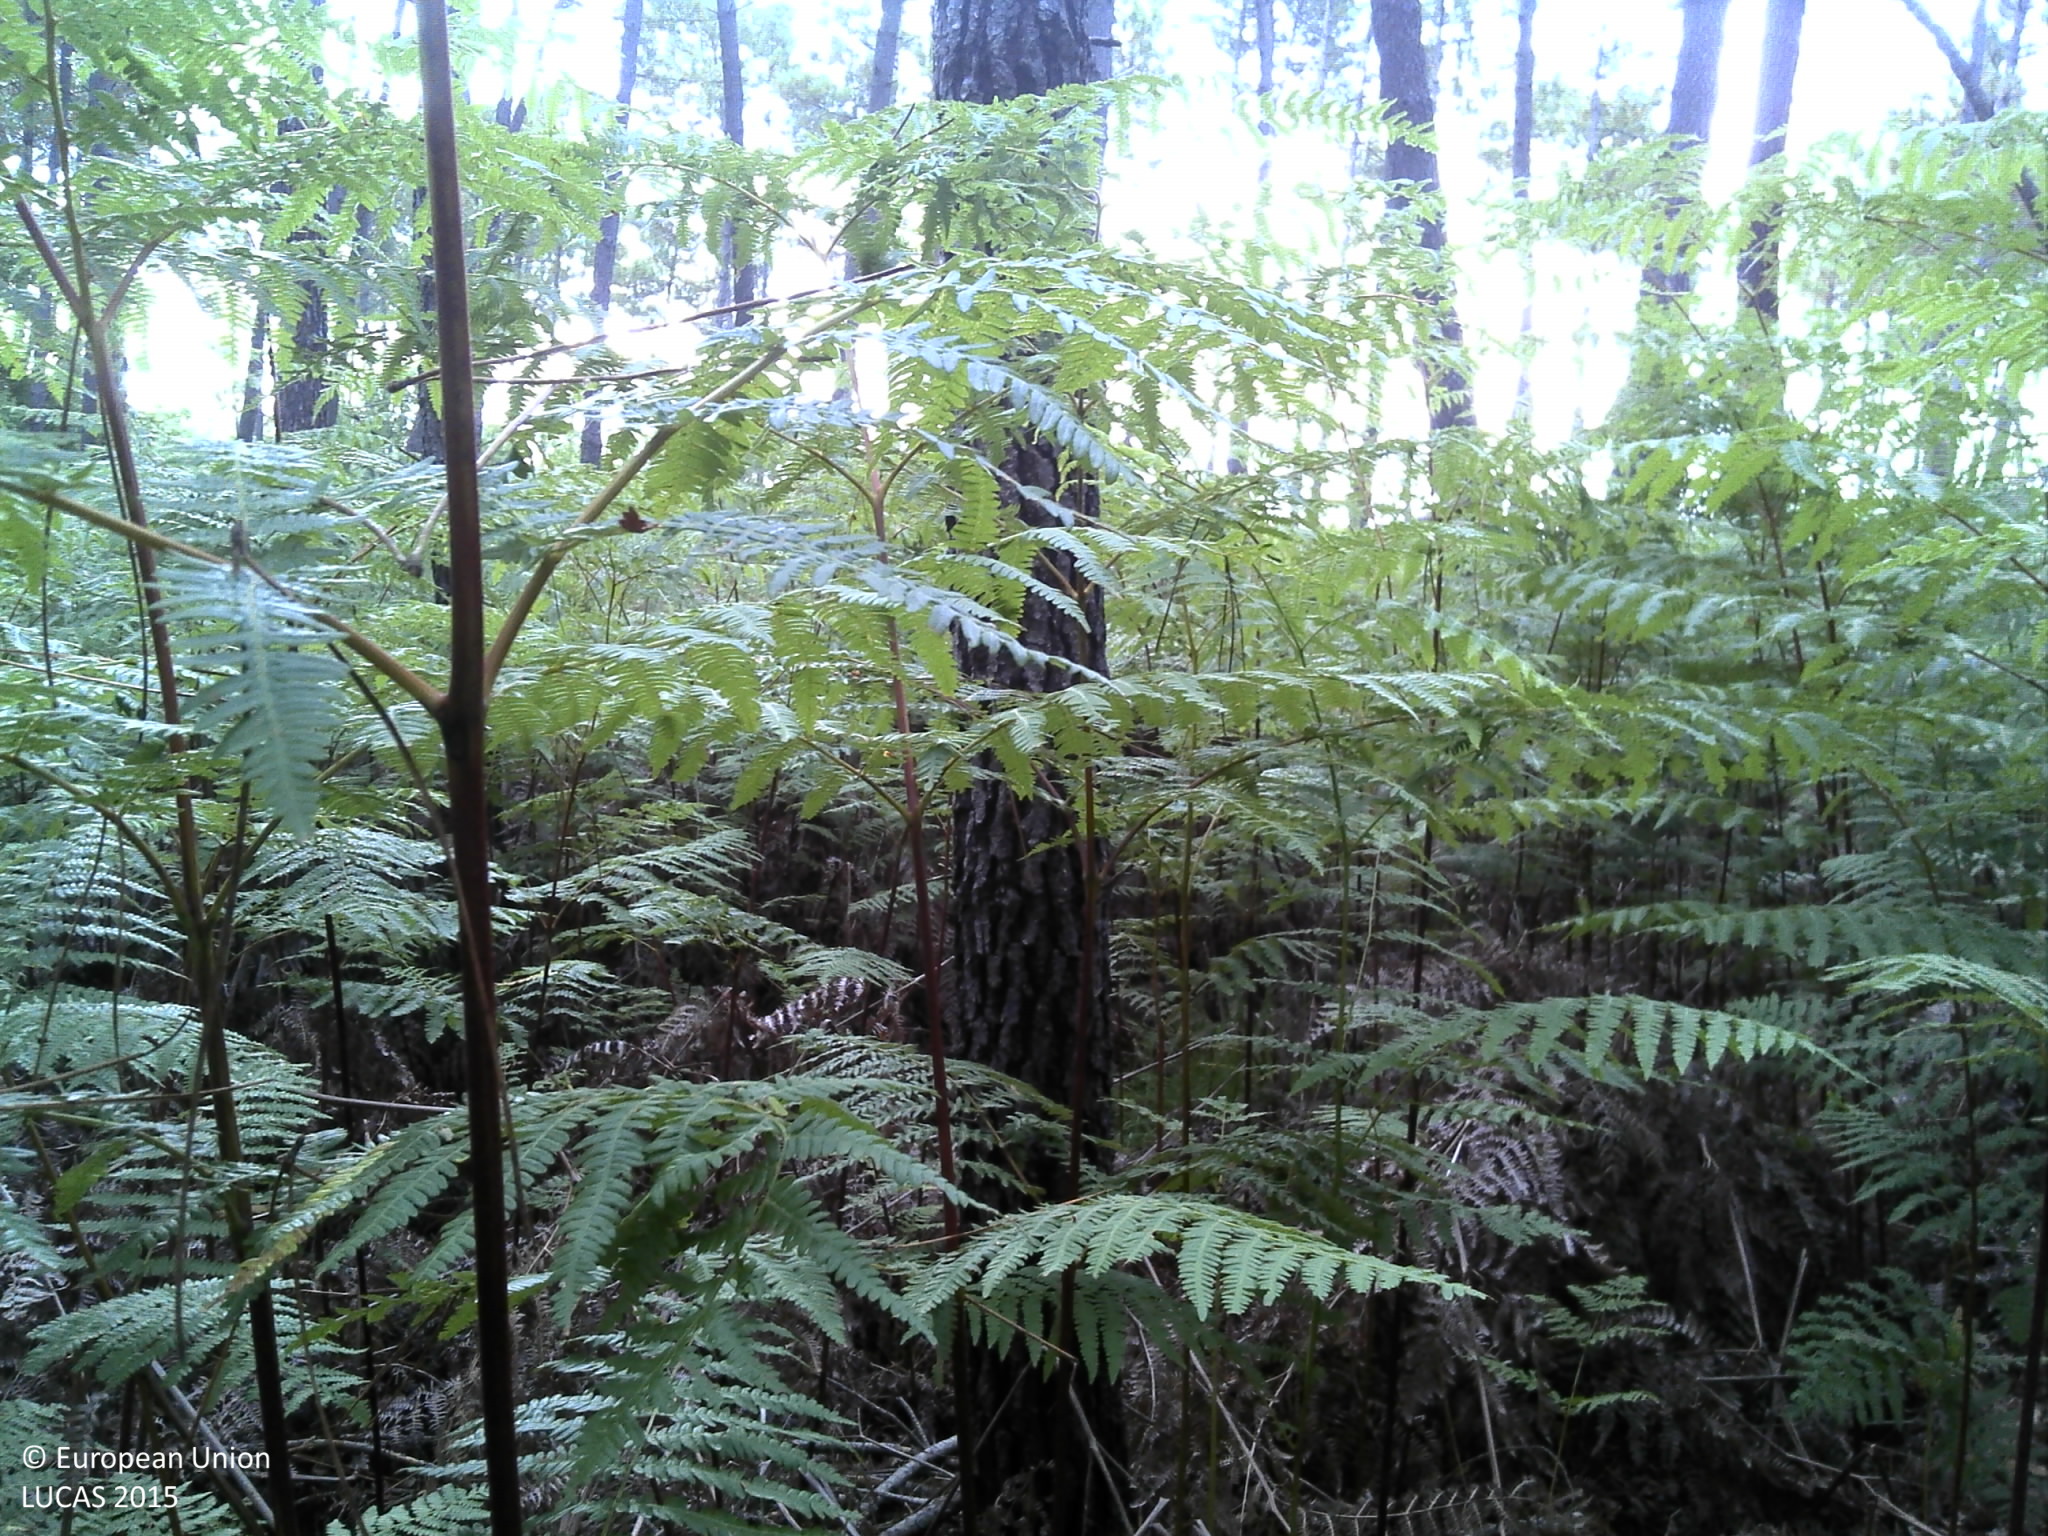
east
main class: Woodland
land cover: Pine dominated coniferous woodland
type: coniferous forest of the mediterranean region
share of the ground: > 75 %
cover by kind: coniferous forest trees 60 %, shrubs 30 %, herbaceous plants 5 %, lichens and mosses 5 %
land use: Forestry
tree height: > 5 m
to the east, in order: Pine dominated coniferous woodland; Pine dominated mixed woodland; Grass margins; Paved roads, cycling and walking lanes; Grass margins; Pine dominated mixed woodland; Grass margins; Paved roads, cycling and walking lanes; Grass margins; Shrubland with sparse tree cover; Grass margins; Paved roads, cycling and walking lanes; Shrubland with sparse tree cover; Broadleaved woodland
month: July
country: FR
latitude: 44.3393
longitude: -0.3612
